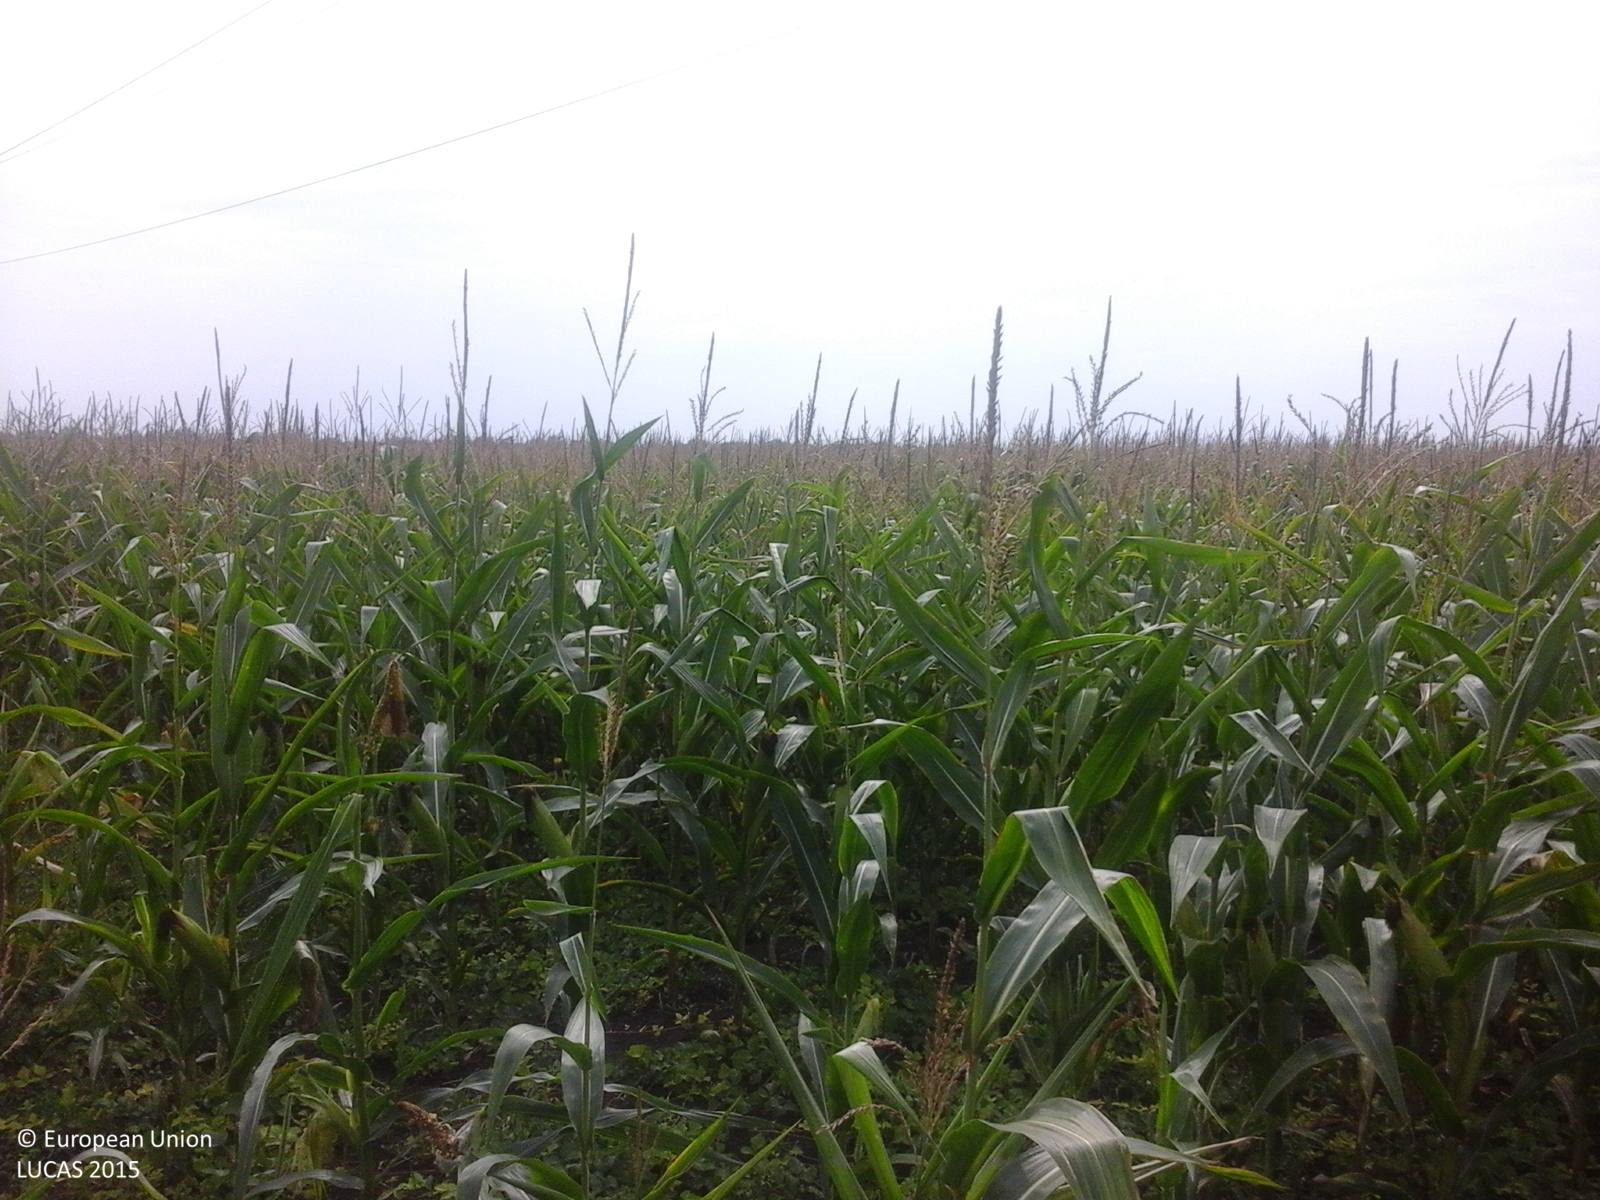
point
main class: Cropland
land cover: Maize
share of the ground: > 75 %
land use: Agriculture (excluding fallow land and kitchen gardens)
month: August
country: RO
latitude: 46.3775
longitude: 21.3857
